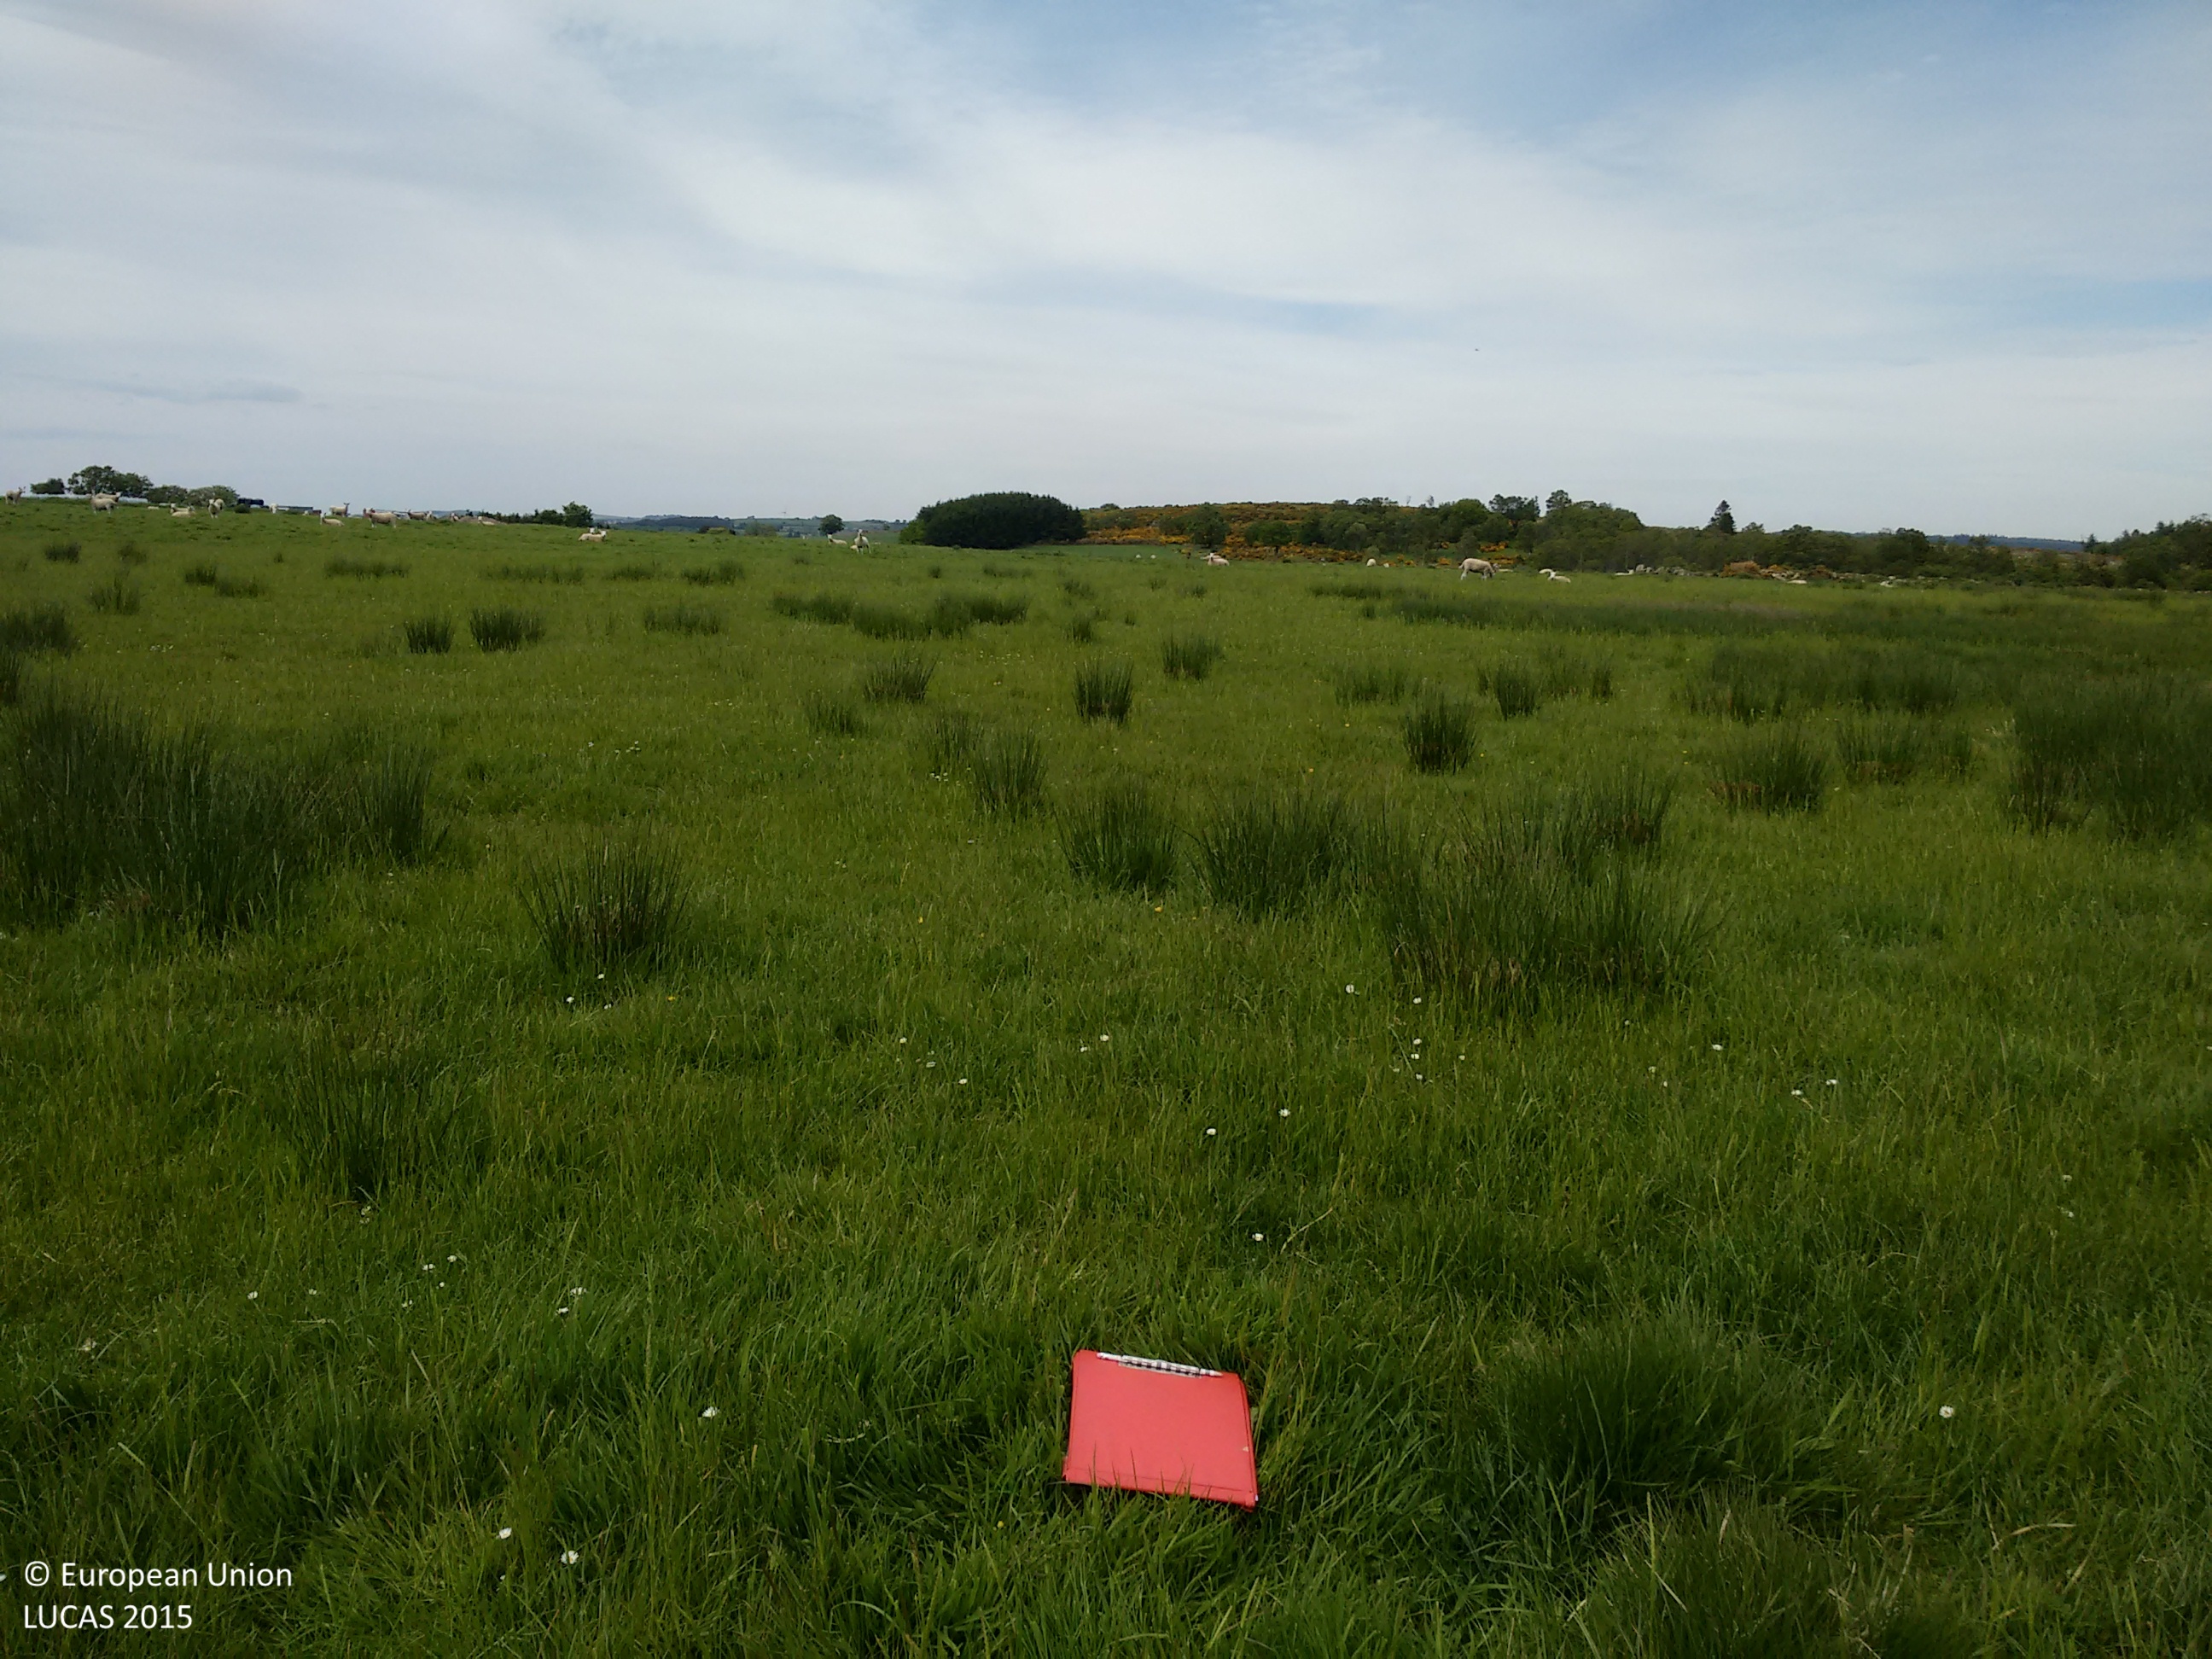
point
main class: Grassland
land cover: Grassland without tree/shrub cover
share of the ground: > 75 %
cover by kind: herbaceous plants 100 %
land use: Agriculture (excluding fallow land and kitchen gardens)
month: June
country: GB
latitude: 57.0743
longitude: -2.2409
